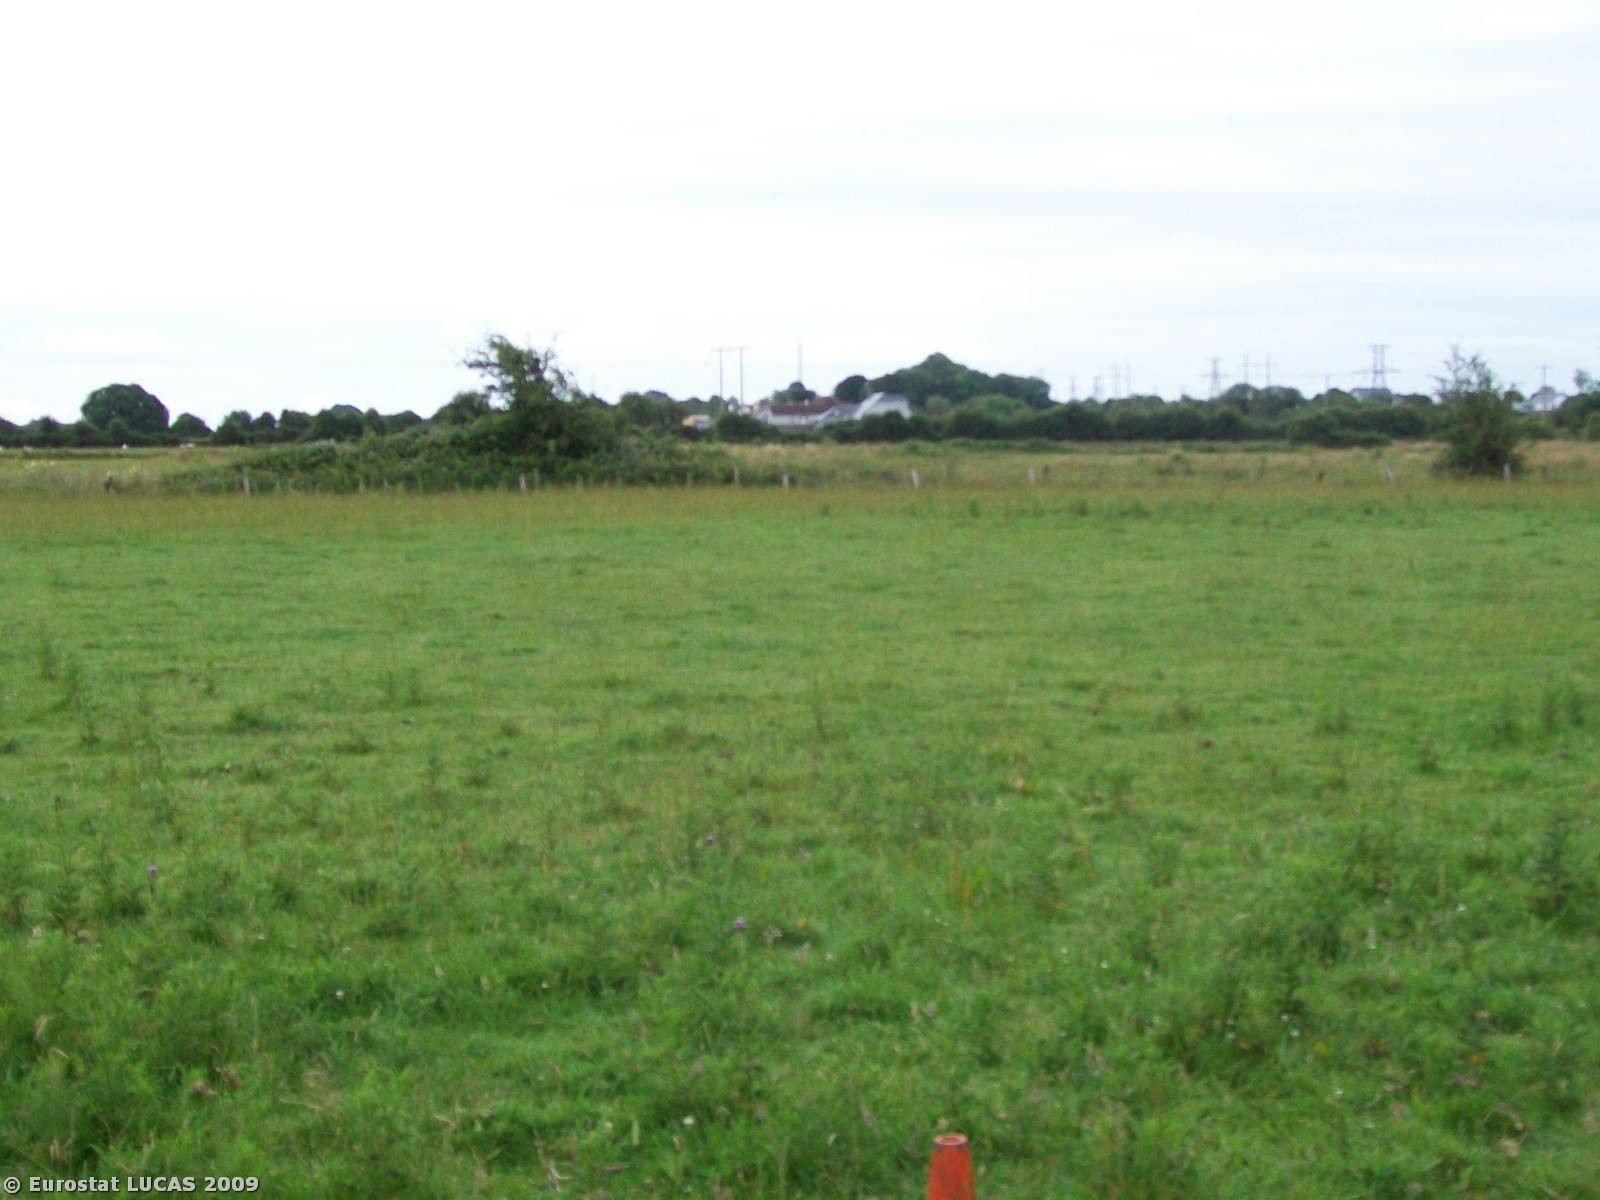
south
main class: Grassland
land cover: Grassland without tree/shrub cover
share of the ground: > 75 %
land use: Agriculture (excluding fallow land and kitchen gardens)
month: July
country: IE
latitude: 53.4920
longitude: -8.8514
